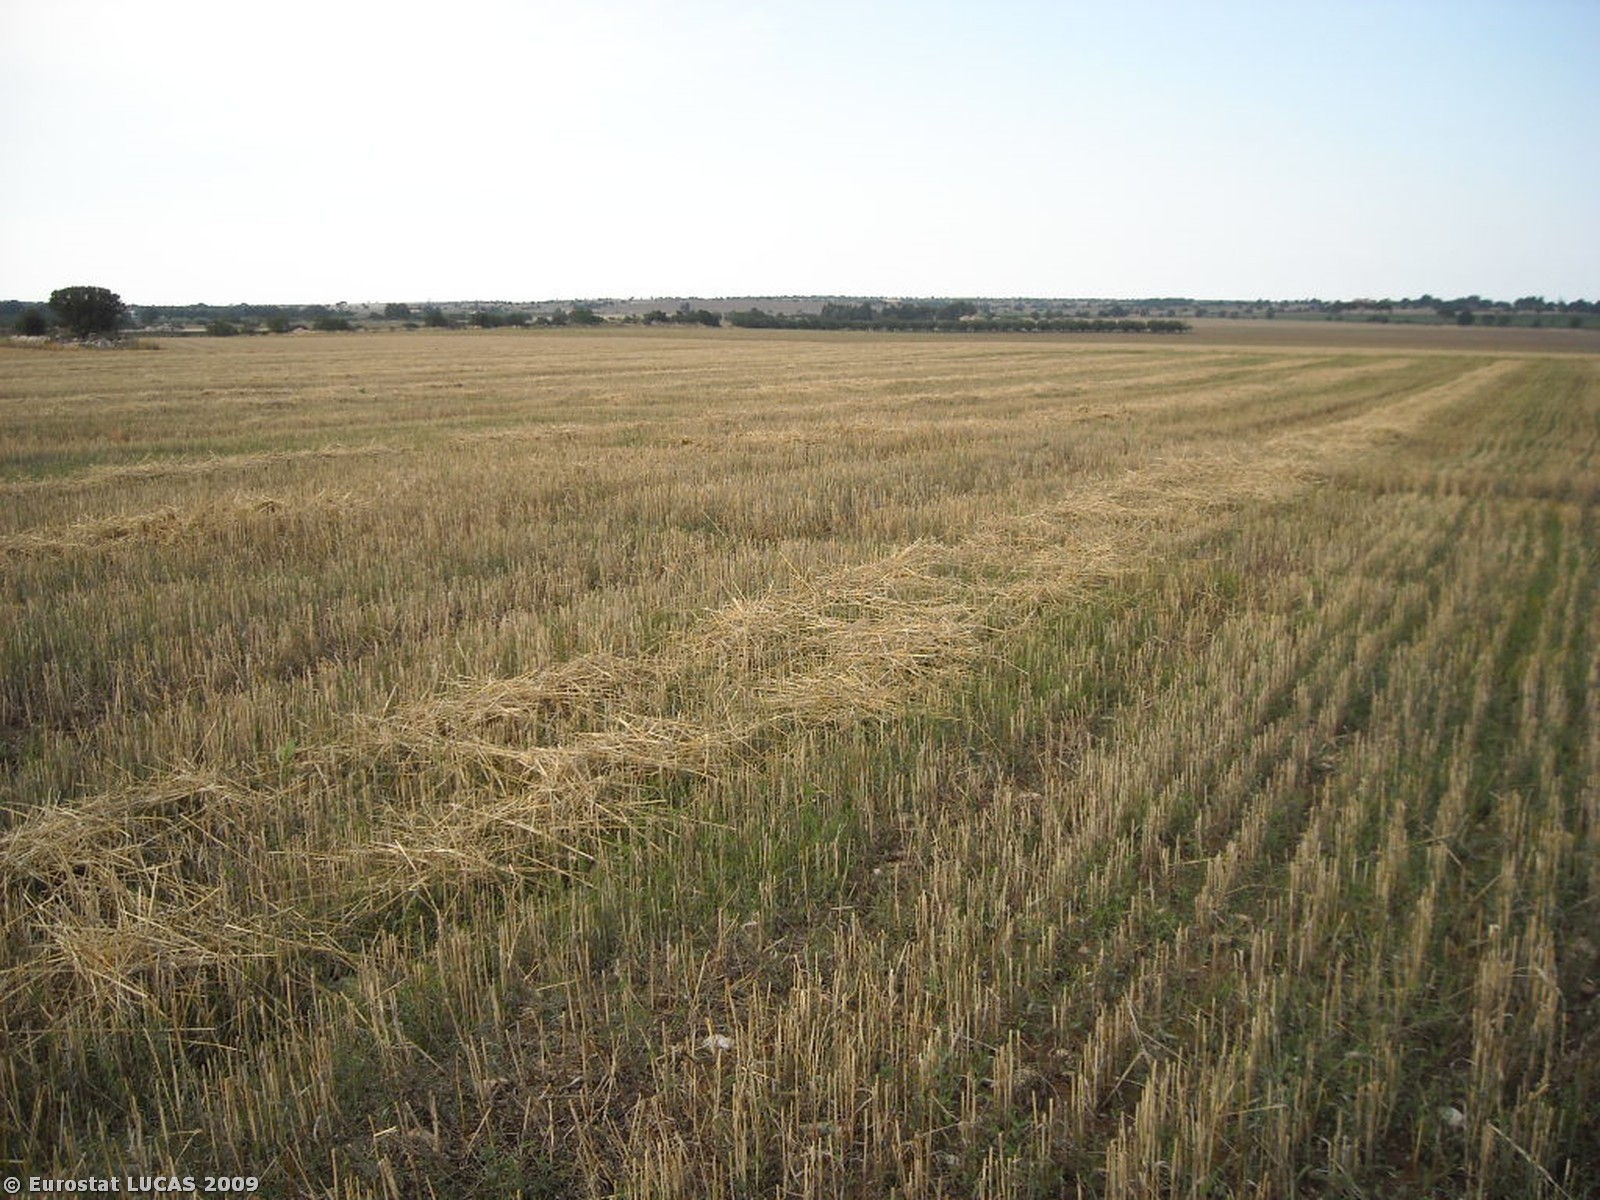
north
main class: Cropland
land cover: Durum wheat
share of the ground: < 10 %
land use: Agriculture (excluding fallow land and kitchen gardens)
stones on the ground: 10 - 25 %
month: July
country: IT
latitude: 41.0236
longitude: 16.3416
